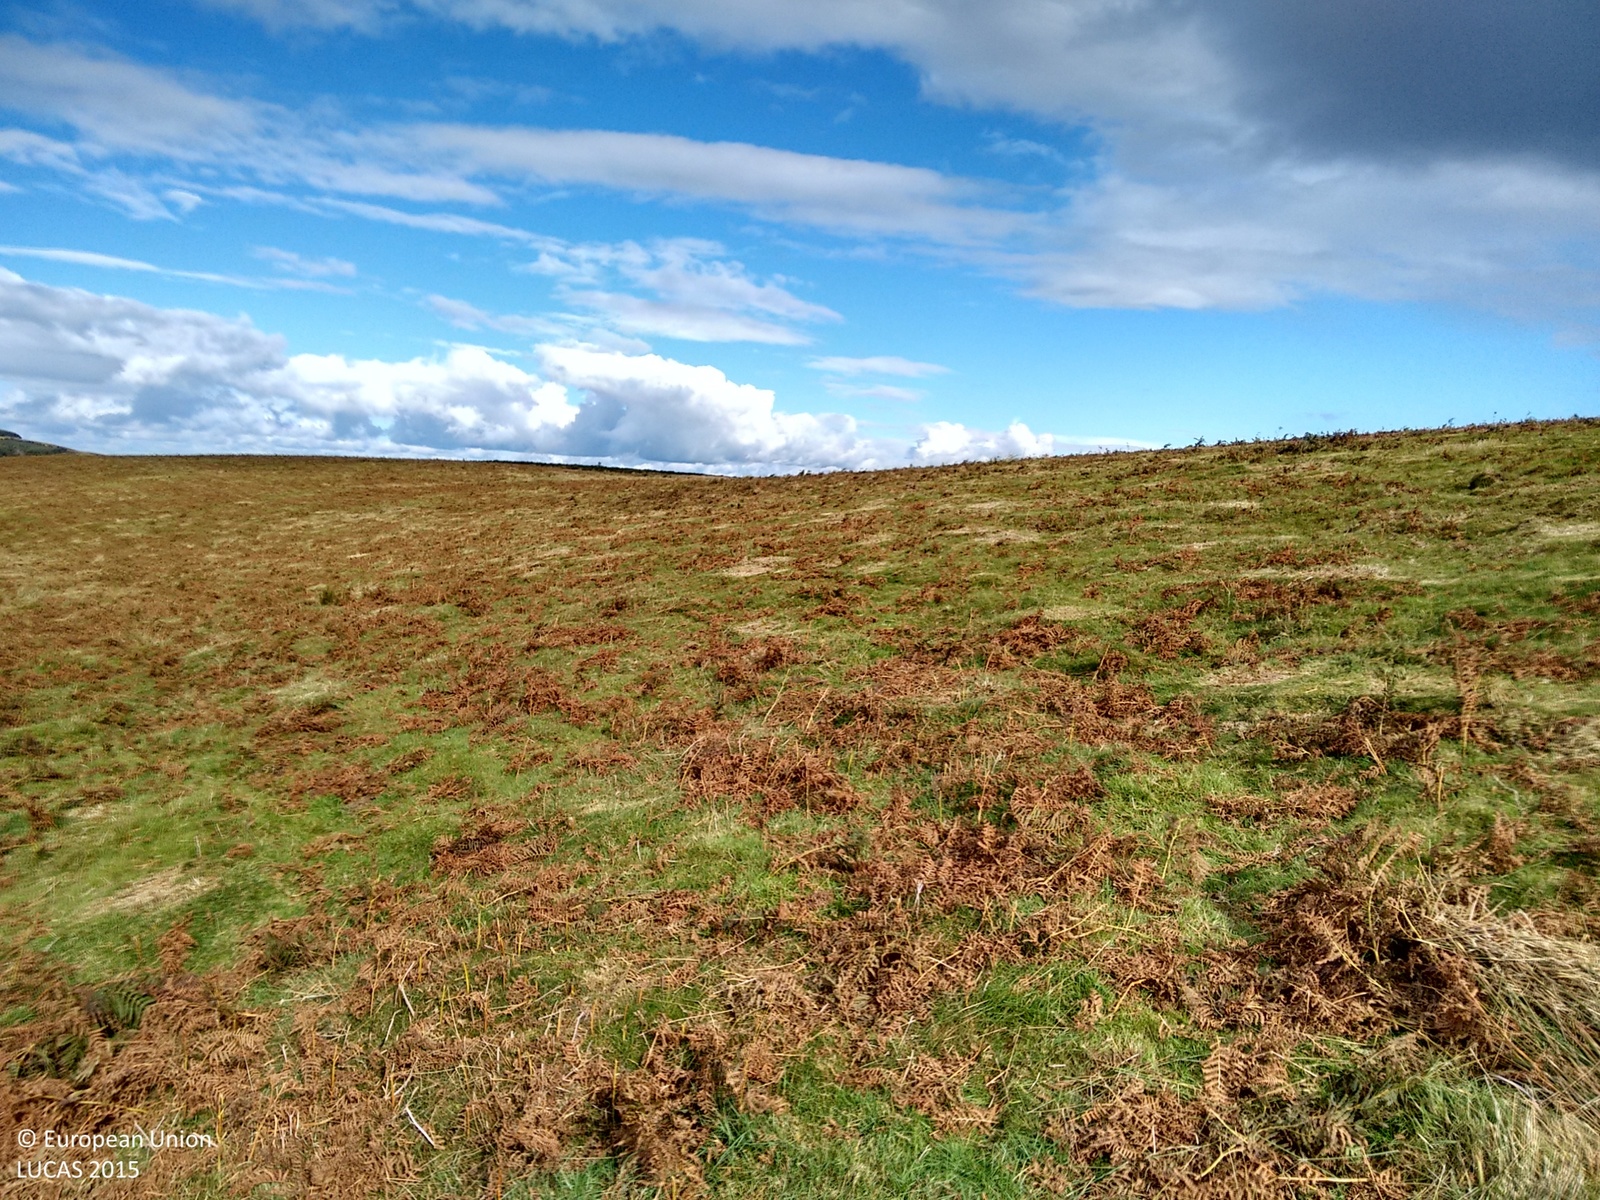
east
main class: Grassland
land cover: Grassland without tree/shrub cover
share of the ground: > 75 %
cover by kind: herbaceous plants 100 %
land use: Agriculture (excluding fallow land and kitchen gardens)
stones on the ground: < 10 %
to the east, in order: Grassland without tree/shrub cover; Tracks; Grassland without tree/shrub cover; Grassland with sparse tree/shrub cover; Tracks; Grassland with sparse tree/shrub cover
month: September
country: GB
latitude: 51.6300
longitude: -3.0933
